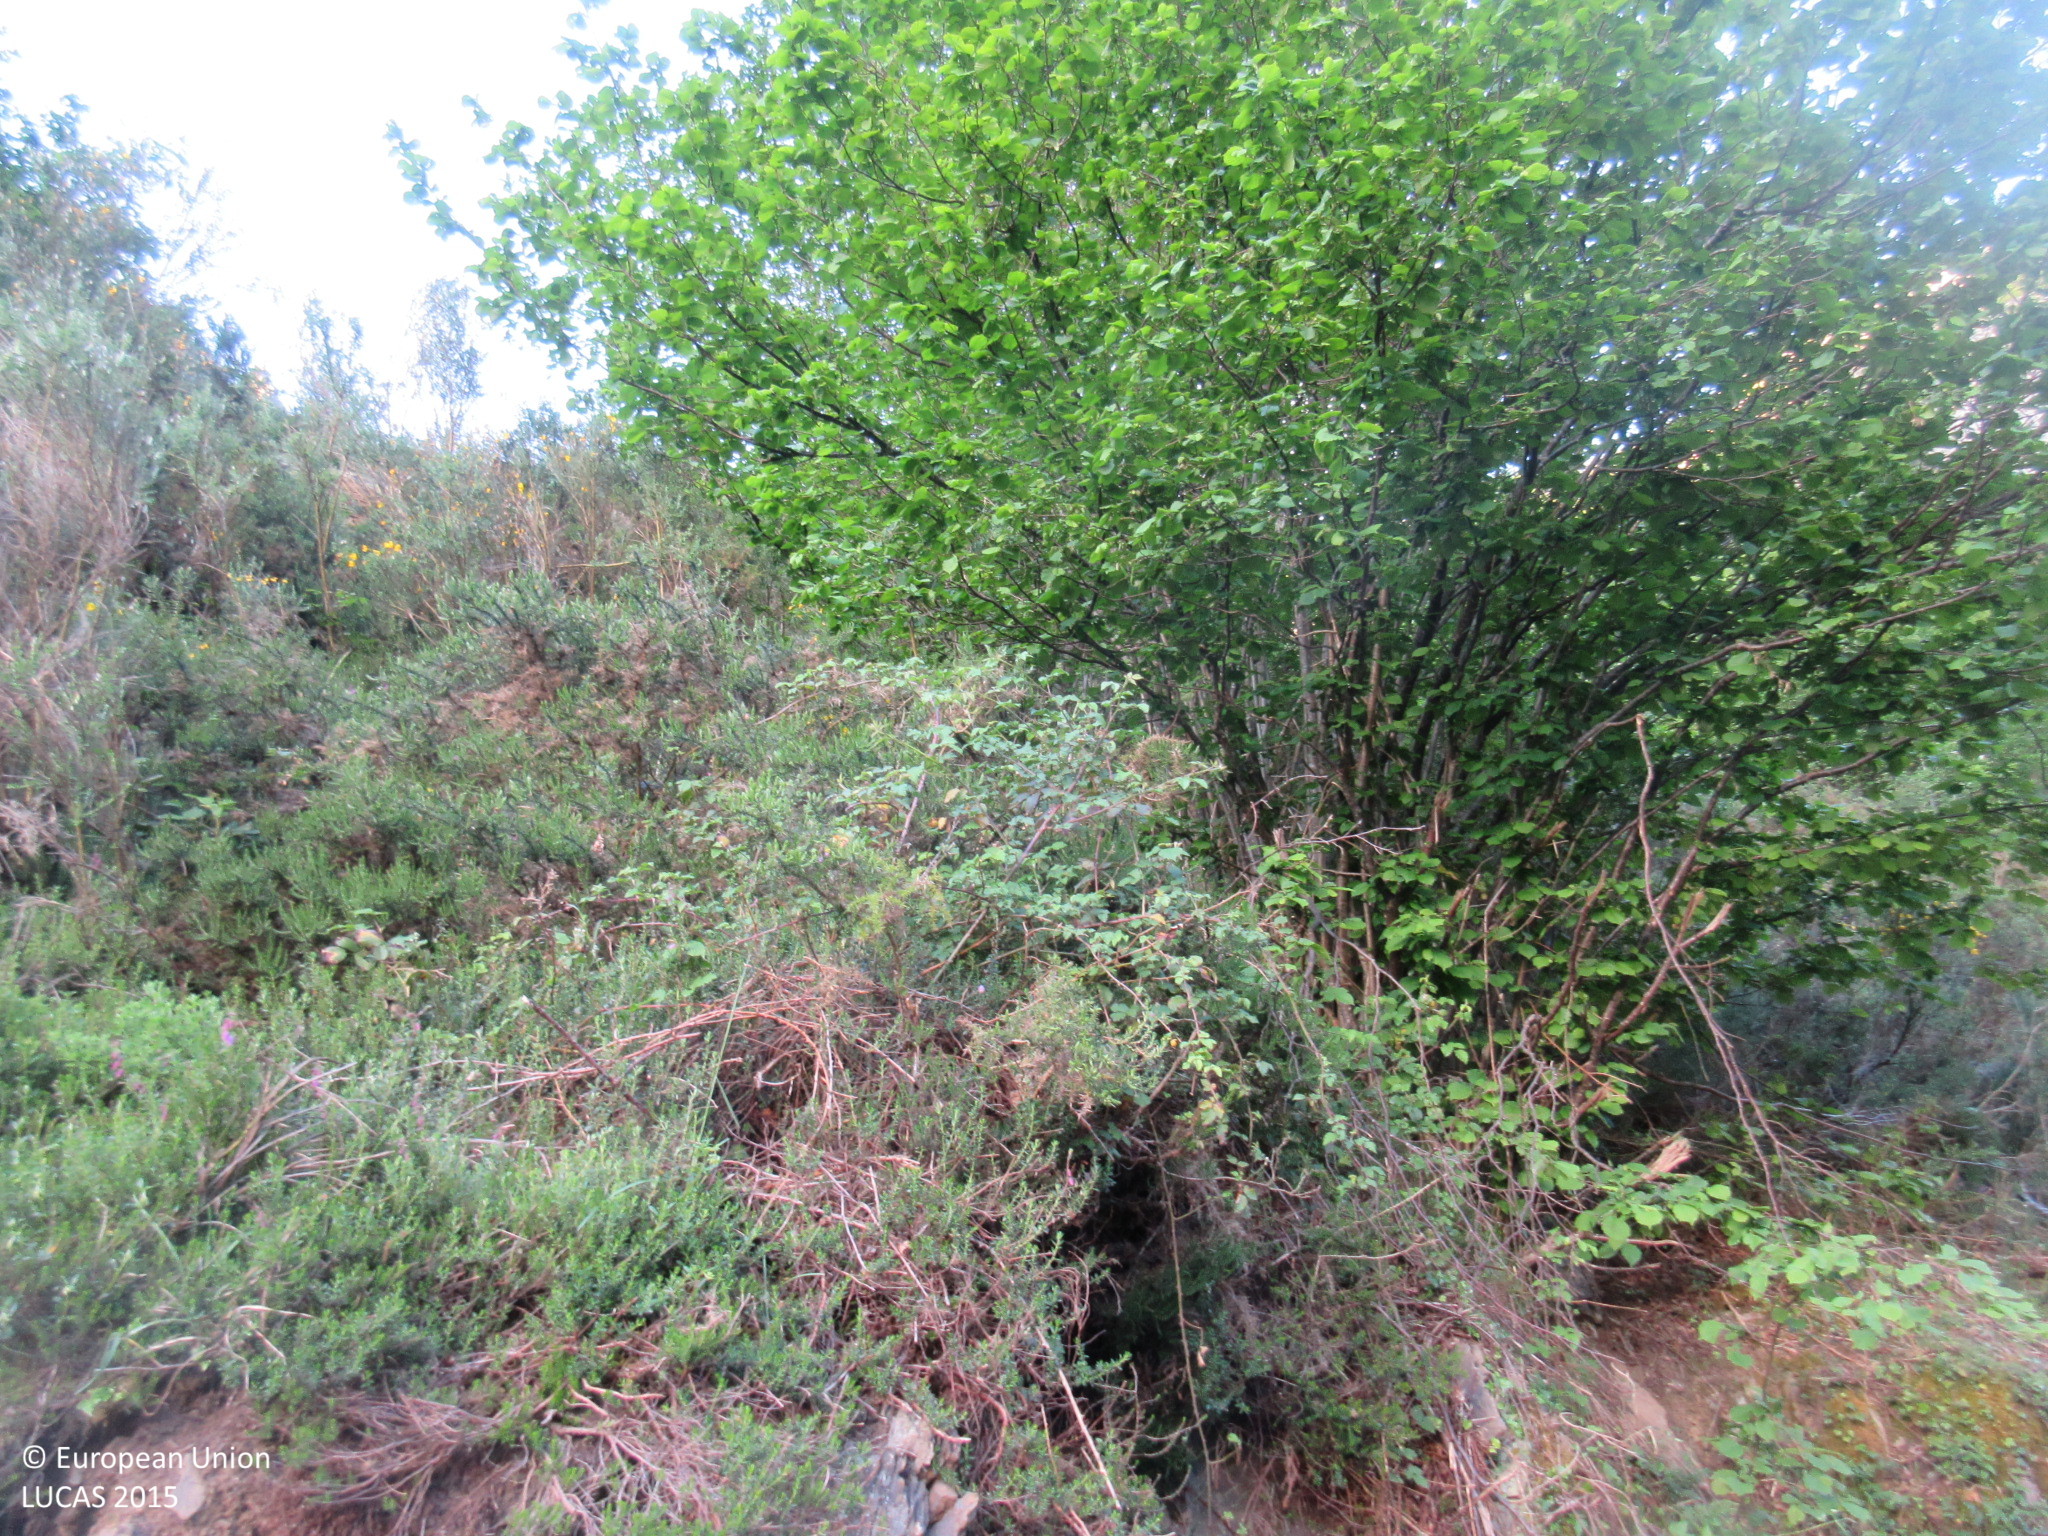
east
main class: Shrubland
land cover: Shrubland with sparse tree cover
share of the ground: > 75 %
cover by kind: shrubs 95 %, broadleaved forest trees 5 %
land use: Semi-natural and natural areas not in use
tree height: > 5 m
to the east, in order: Shrubland with sparse tree cover; Shrubland without tree cover; Broadleaved woodland
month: May
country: ES
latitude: 43.0830
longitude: -5.5174
